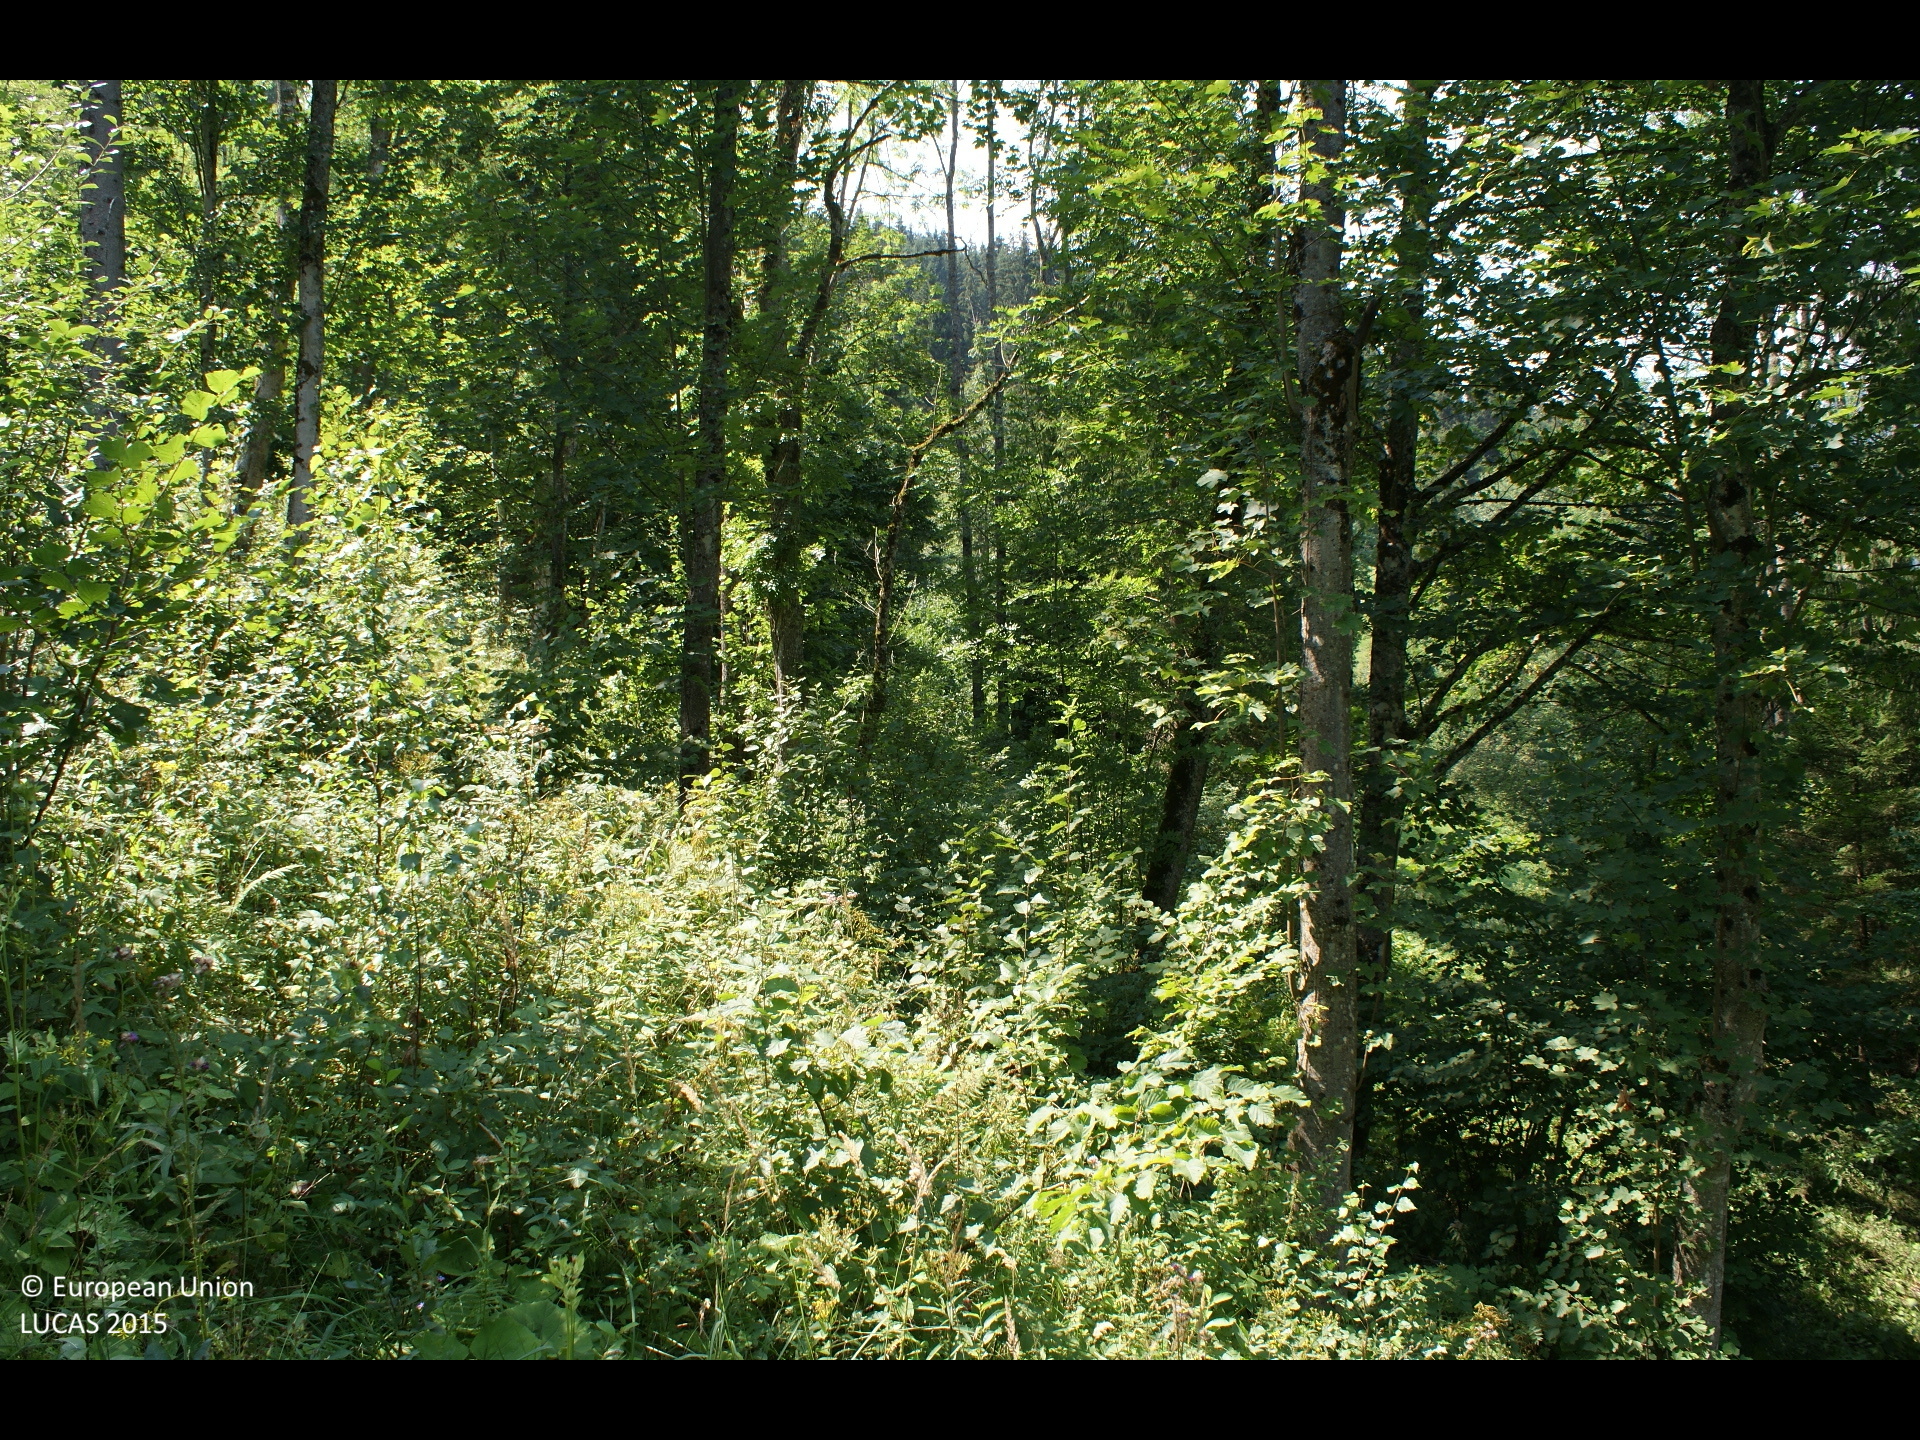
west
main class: Shrubland
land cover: Shrubland with sparse tree cover
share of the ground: > 75 %
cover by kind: shrubs 75 %, herbaceous plants 20 %, broadleaved forest trees 5 %
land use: Forestry
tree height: < 5 m
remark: Clear cut
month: August
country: AT
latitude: 47.7151
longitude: 15.3462
